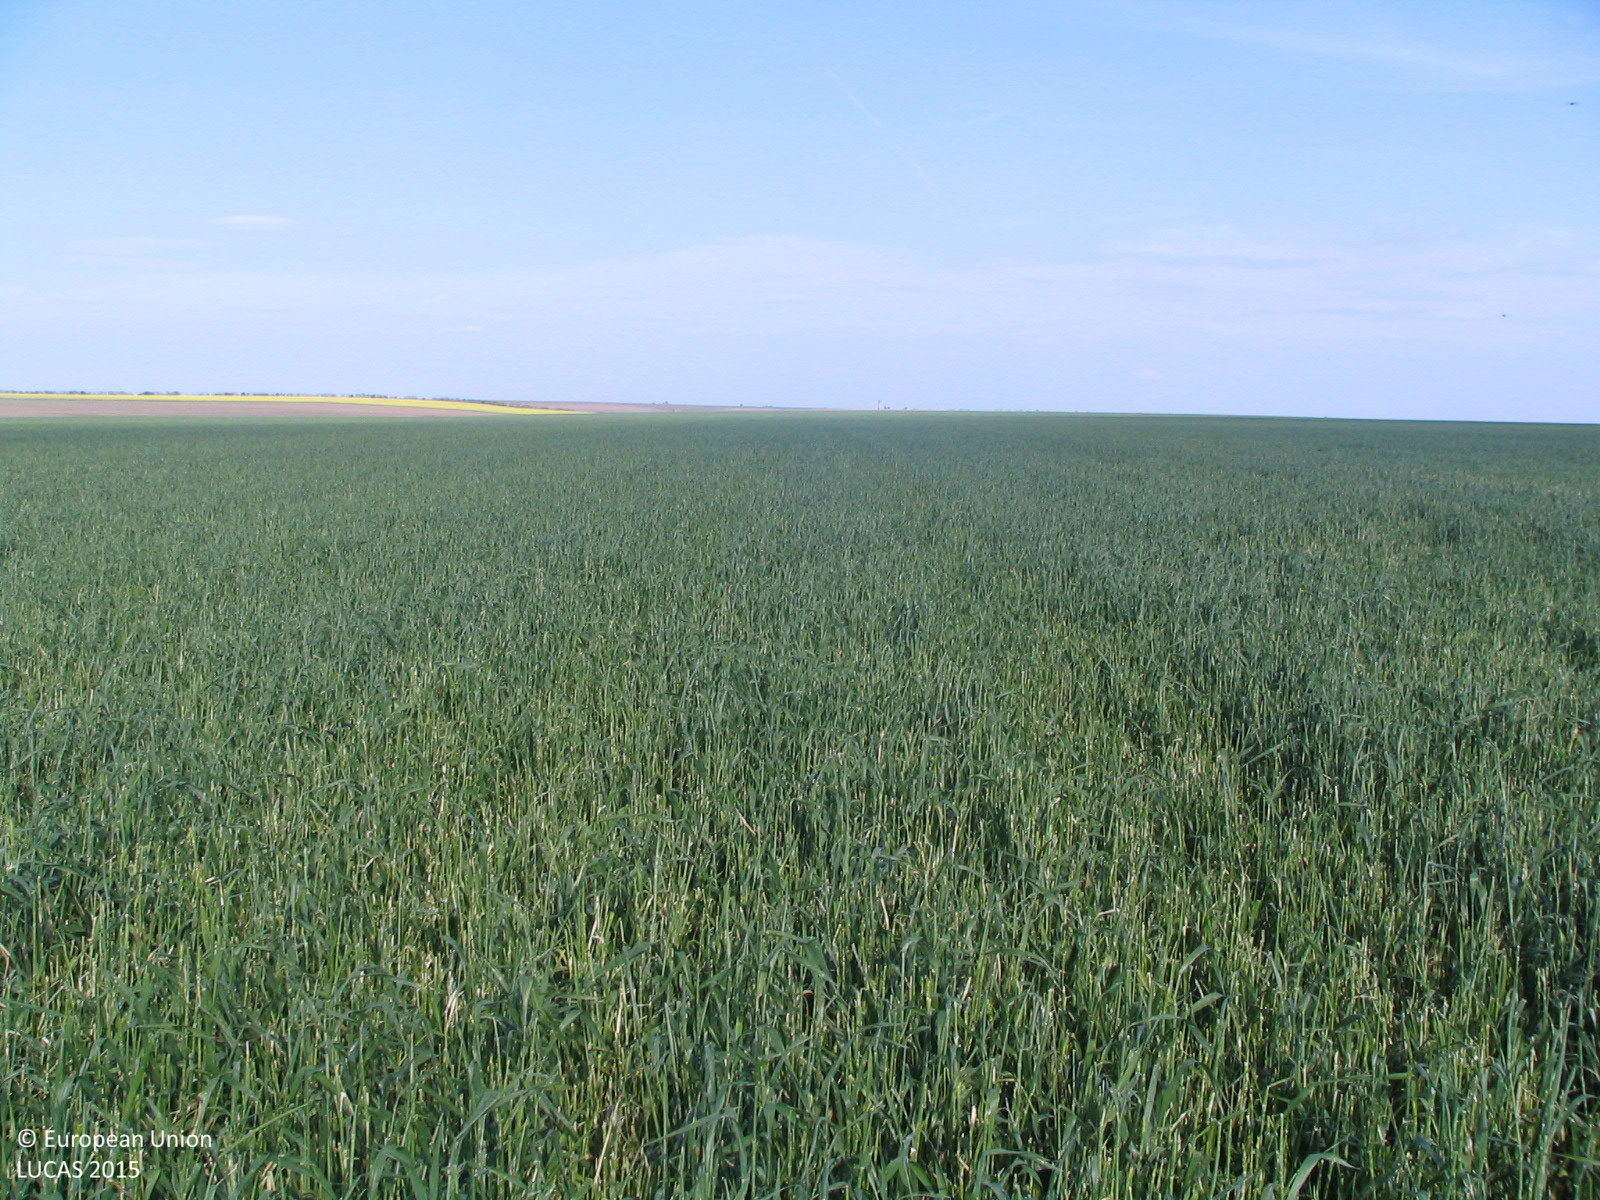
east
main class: Cropland
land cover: Common wheat
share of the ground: > 75 %
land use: Agriculture (excluding fallow land and kitchen gardens)
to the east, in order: Common wheat
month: May
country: BG
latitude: 43.5632
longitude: 23.9810
